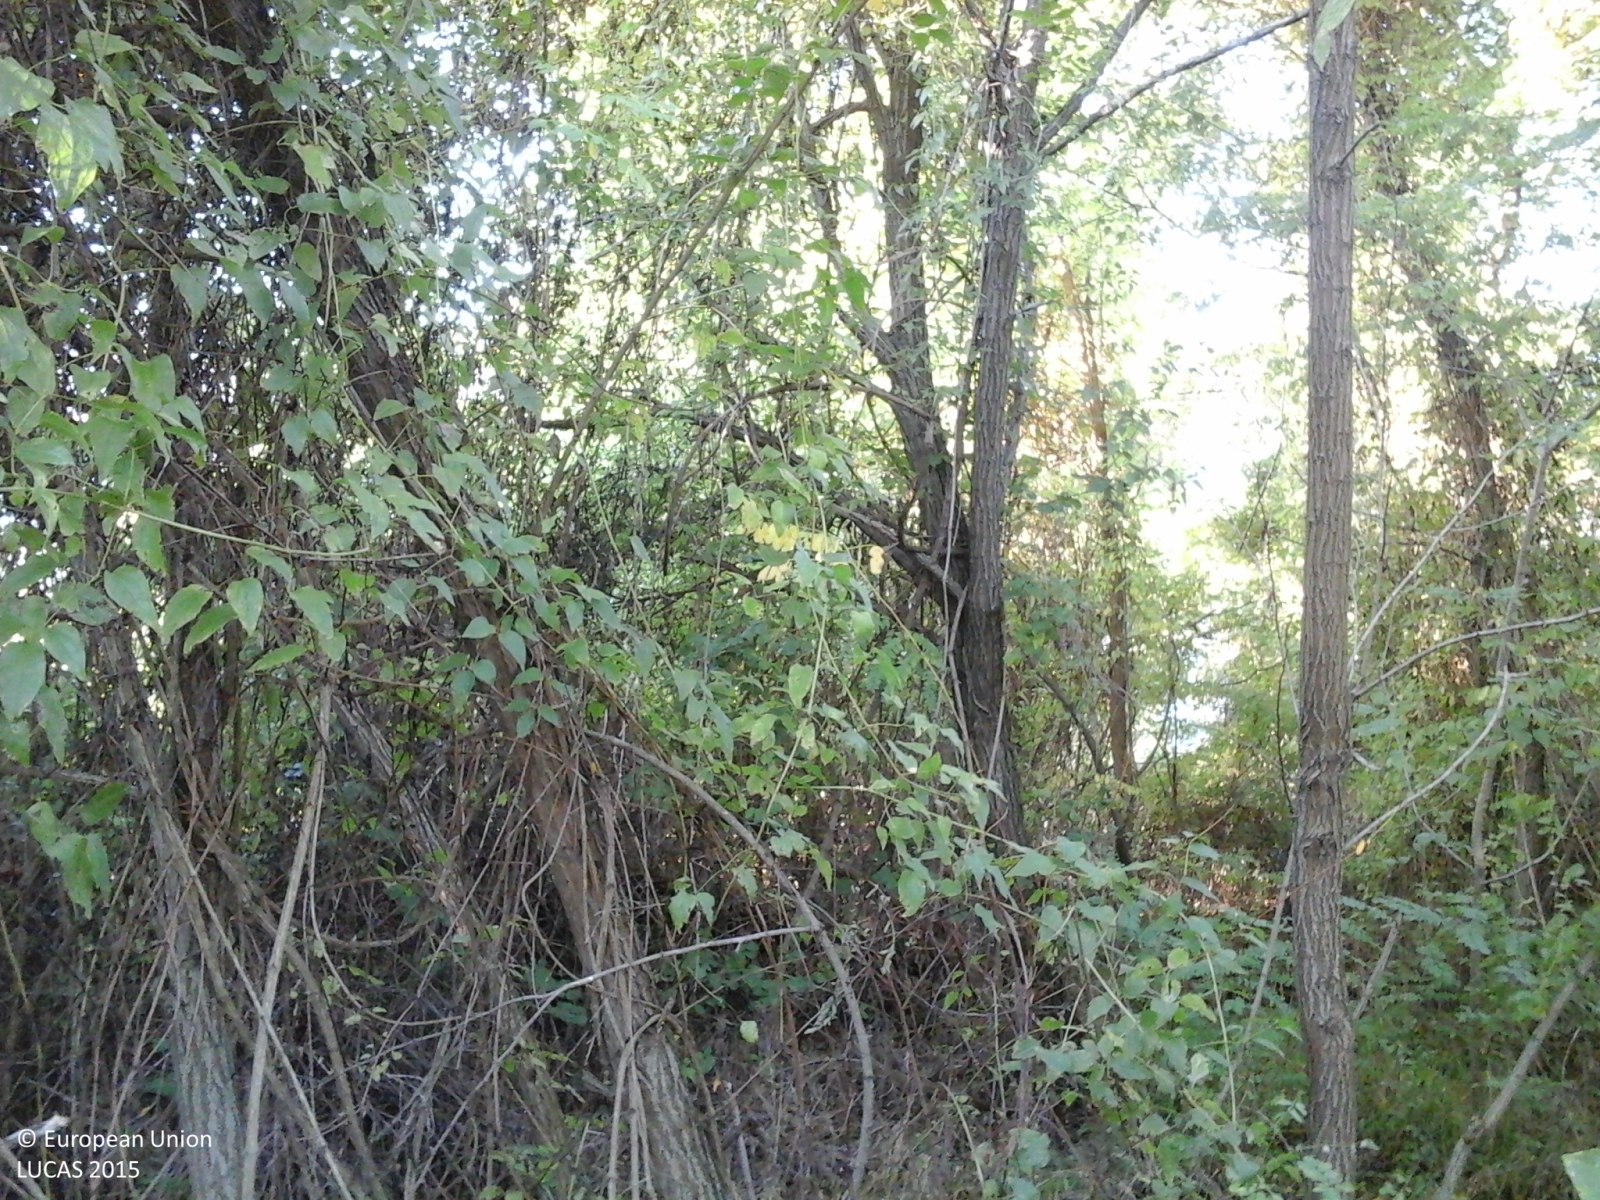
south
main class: Woodland
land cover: Broadleaved woodland
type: thermophilous deciduous forest
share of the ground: > 75 %
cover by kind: broadleaved forest trees 70 %, shrubs 15 %, herbaceous plants 10 %, coniferous forest trees 5 %
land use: Forestry
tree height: > 5 m
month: October
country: IT
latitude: 44.0756
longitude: 7.8448
